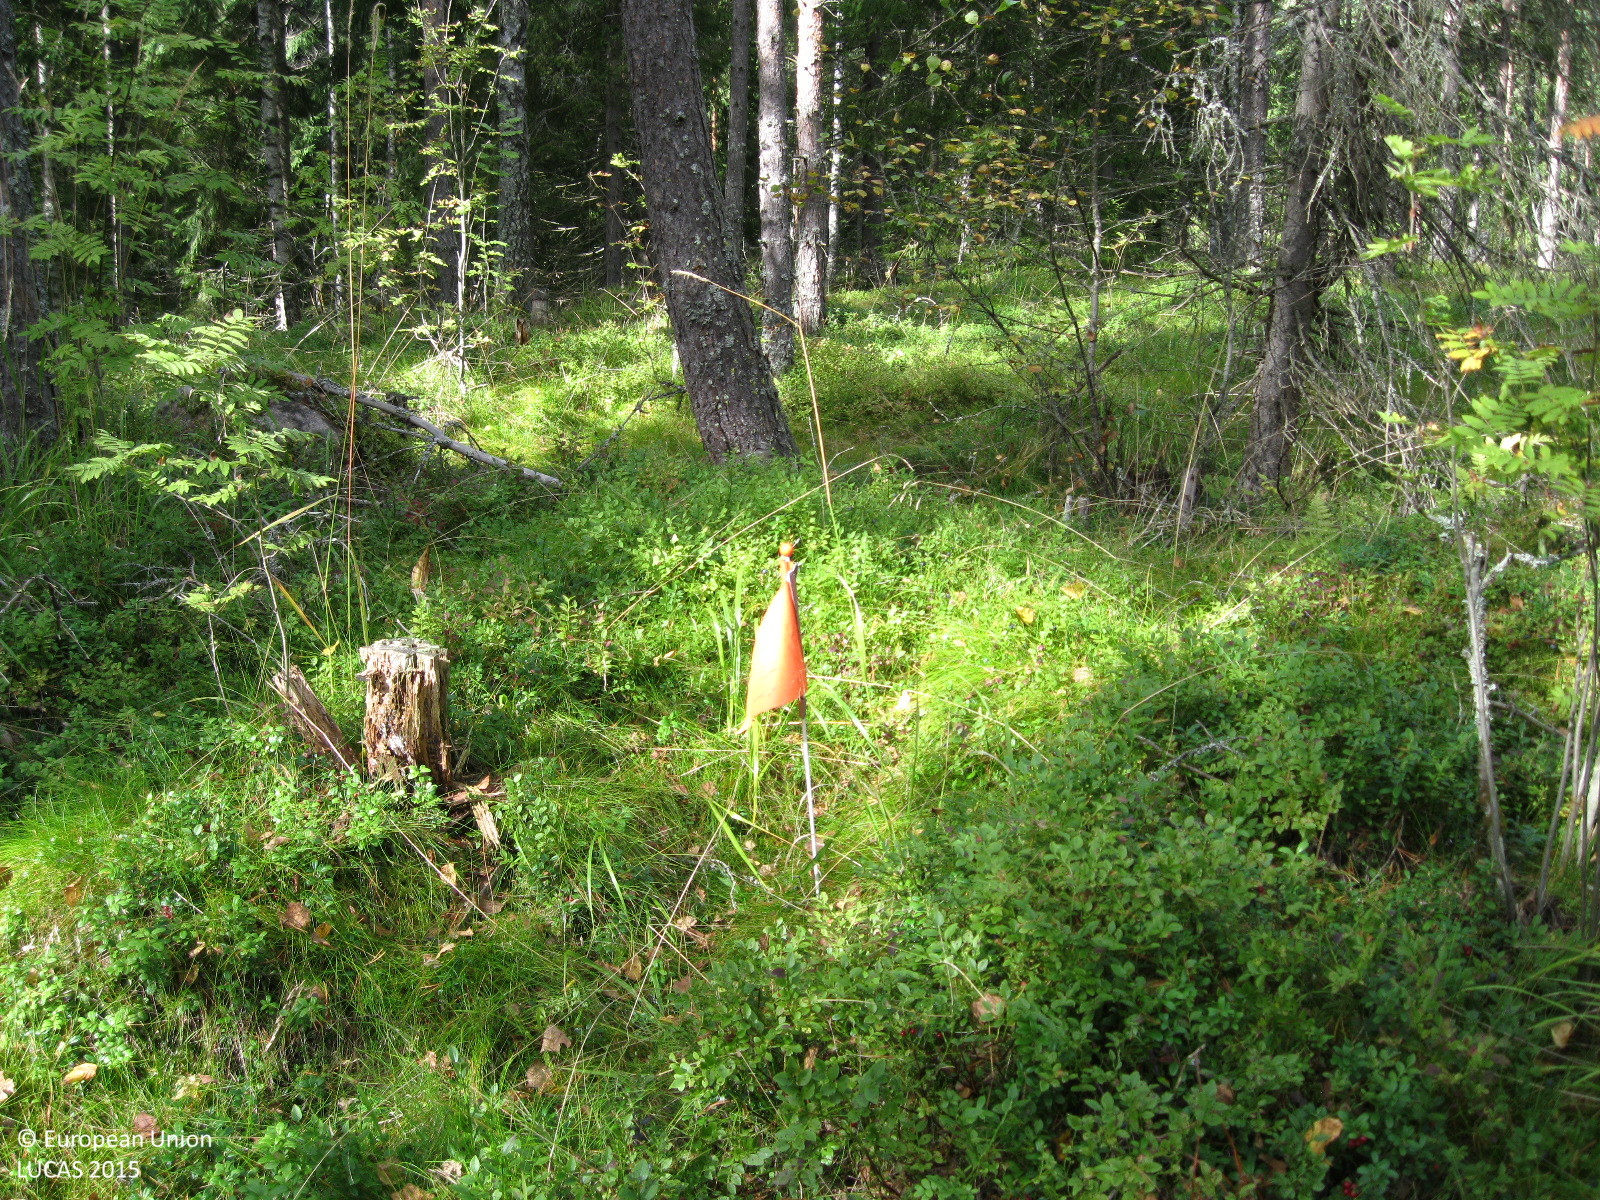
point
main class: Woodland
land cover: Other mixed woodland
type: boreal forest
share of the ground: > 75 %
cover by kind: coniferous forest trees 55 %, broadleaved forest trees 20 %, shrubs 10 %, lichens and mosses 10 %, herbaceous plants 5 %
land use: Forestry
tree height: > 5 m
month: September
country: FI
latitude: 60.4124
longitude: 24.5423
